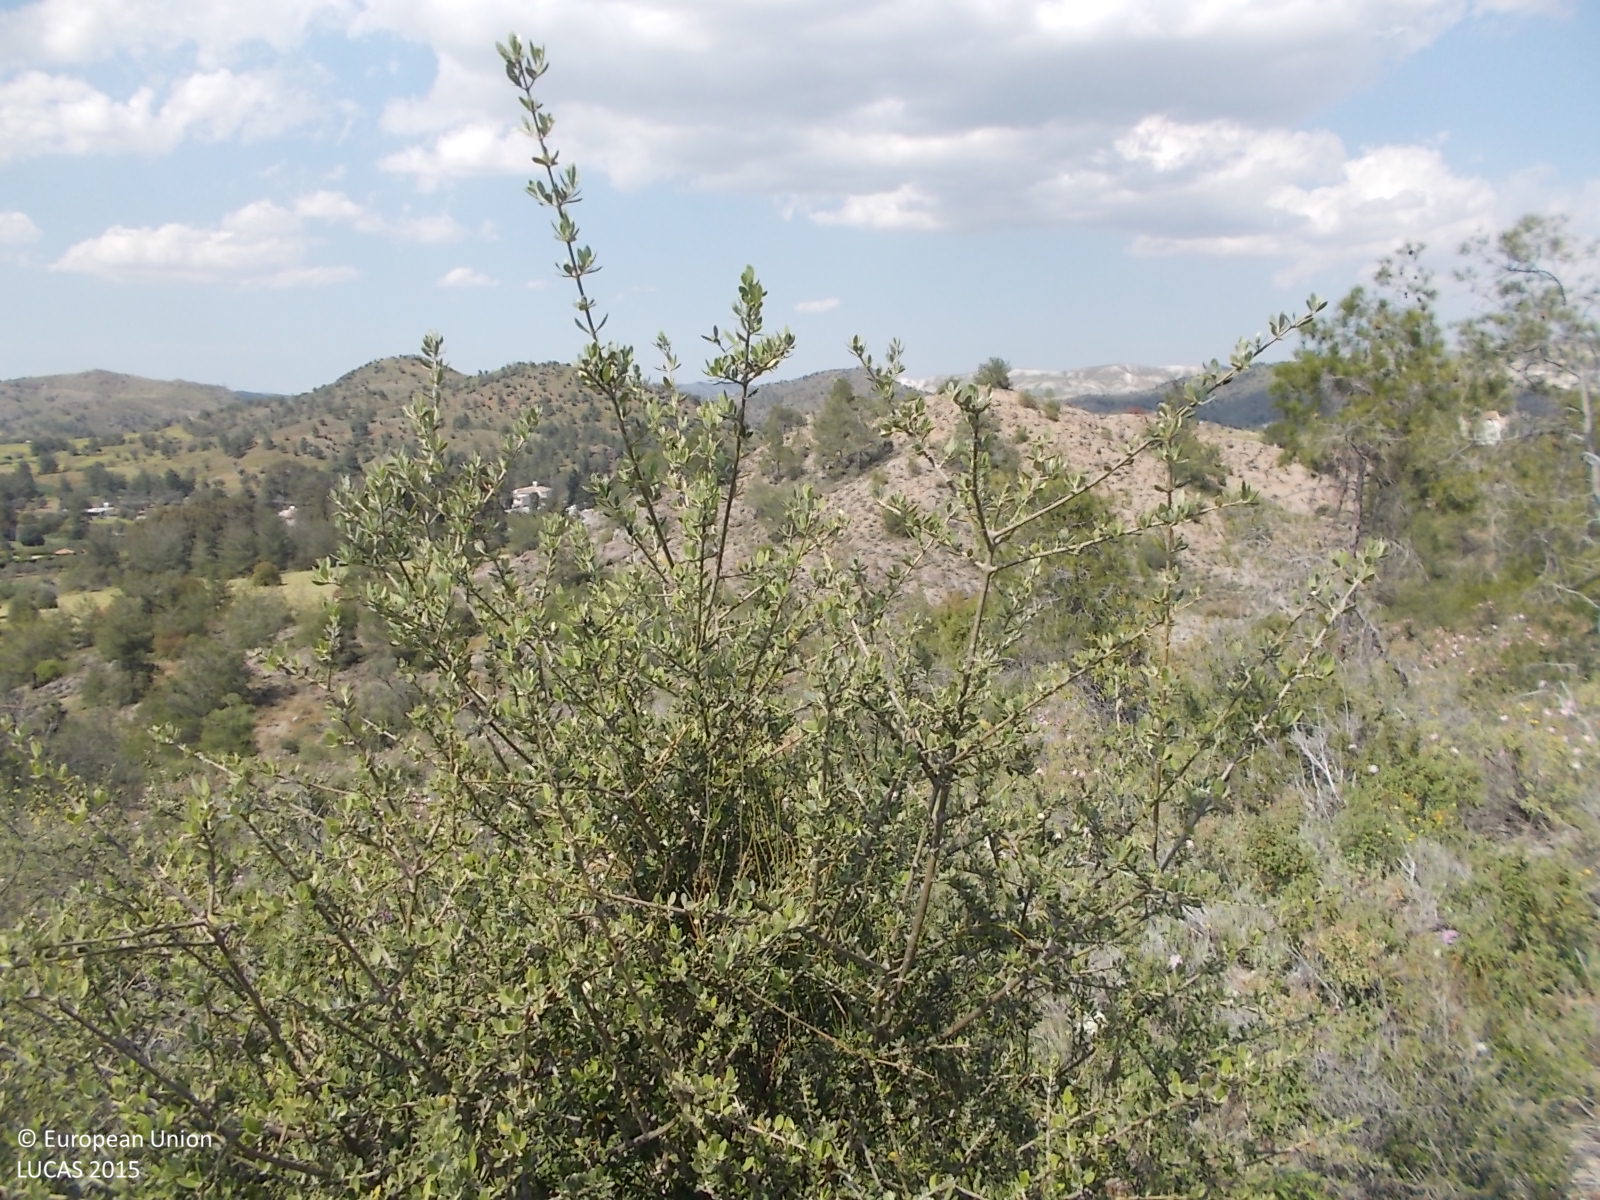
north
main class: Woodland
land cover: Pine dominated coniferous woodland
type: coniferous forest of the mediterranean region
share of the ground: > 75 %
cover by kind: shrubs 70 %, coniferous forest trees 25 %, broadleaved forest trees 5 %
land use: Forestry
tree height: < 5 m
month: April
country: CY
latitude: 34.9389
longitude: 33.4559
